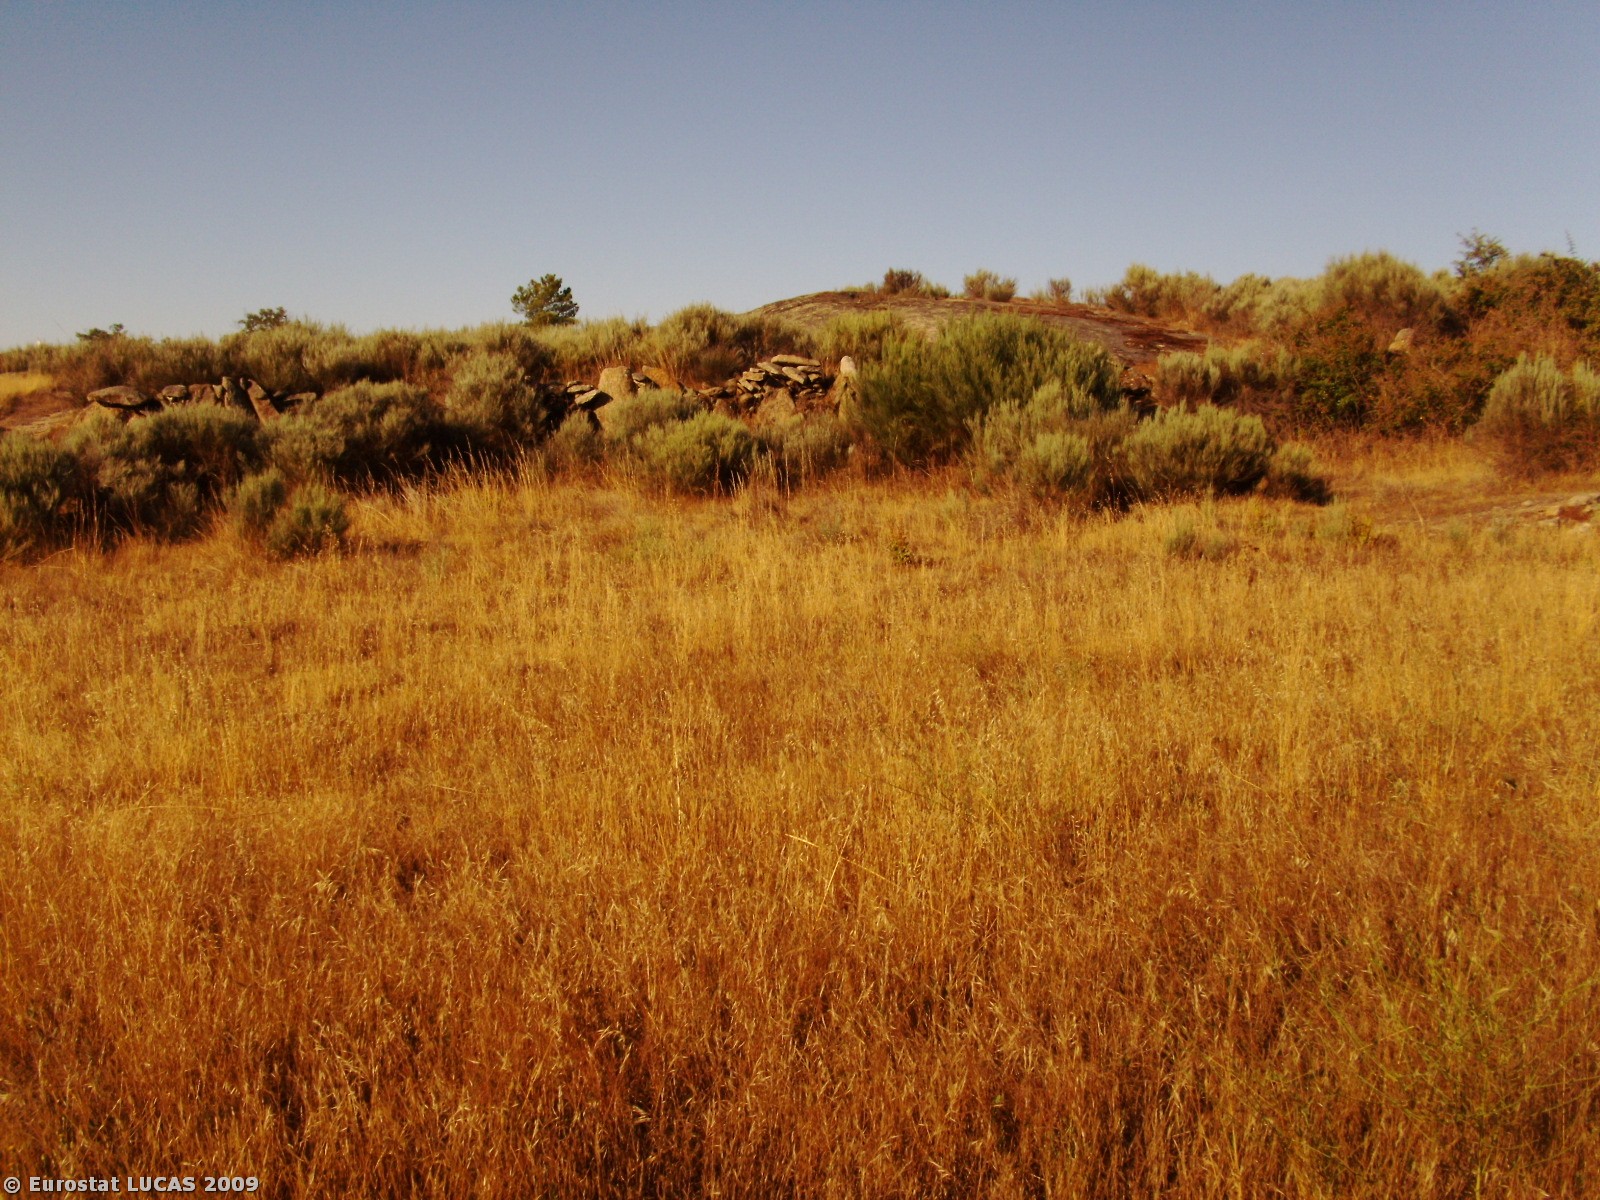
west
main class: Shrubland
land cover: Shrubland without tree cover
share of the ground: > 75 %
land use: Unused
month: July
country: PT
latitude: 40.5827
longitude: -7.0792
